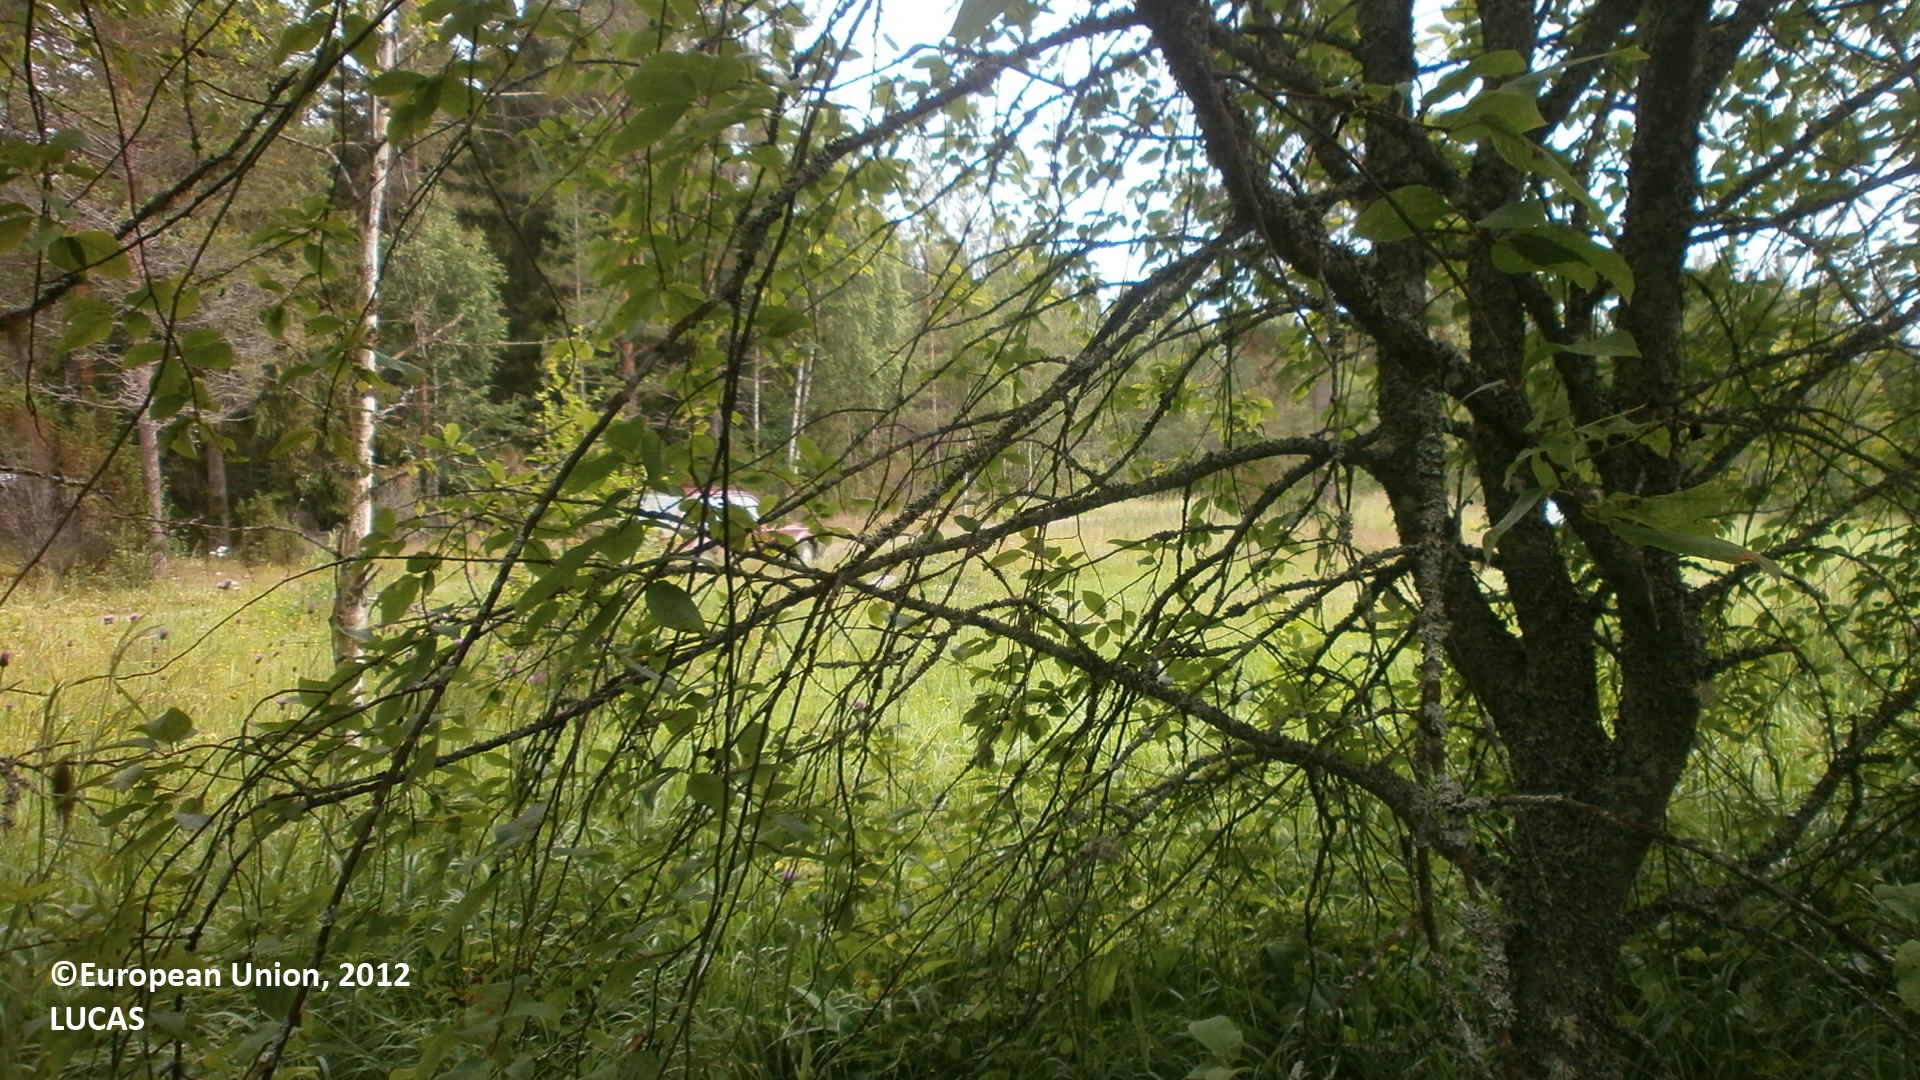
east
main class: Woodland
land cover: Broadleaved woodland
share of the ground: 10 - 25 %
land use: Residential
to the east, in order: Broadleaved woodland; Grassland without tree/shrub cover; Single bushes/trees; Grassland without tree/shrub cover; Tracks; Grass margins; Pine dominated coniferous woodland; Tracks; Pine dominated coniferous woodland; Ditches and canals; Grass margins; Barley; Grass margins; Ditches and canals; Pine dominated mixed woodland; Ditches and canals; Shruby margins; Temporary grasslands; Electric lines; Temporary grasslands
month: July
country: FI
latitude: 64.2555
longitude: 24.3690
